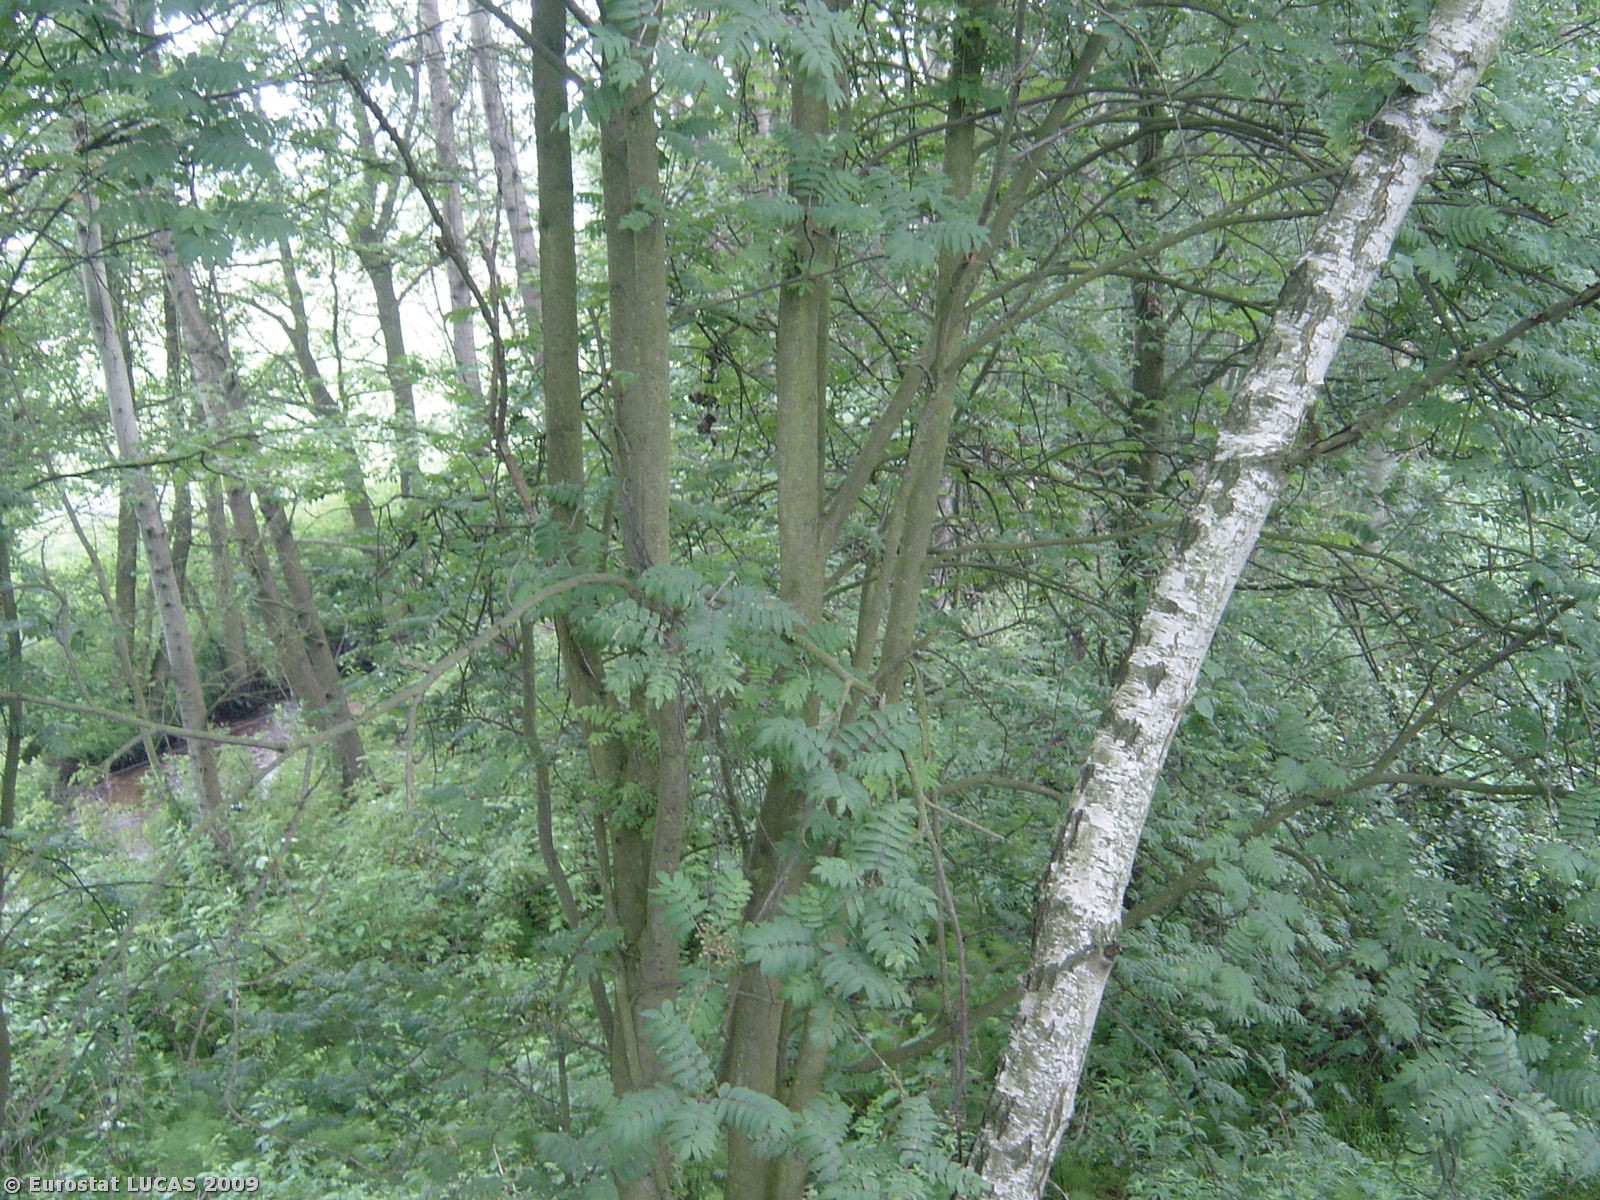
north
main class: Woodland
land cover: Broadleaved woodland
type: acidophilous oak and oak-birch forest
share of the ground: > 75 %
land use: Unused
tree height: > 5 m
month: July
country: CZ
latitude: 50.0117
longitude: 12.5534
